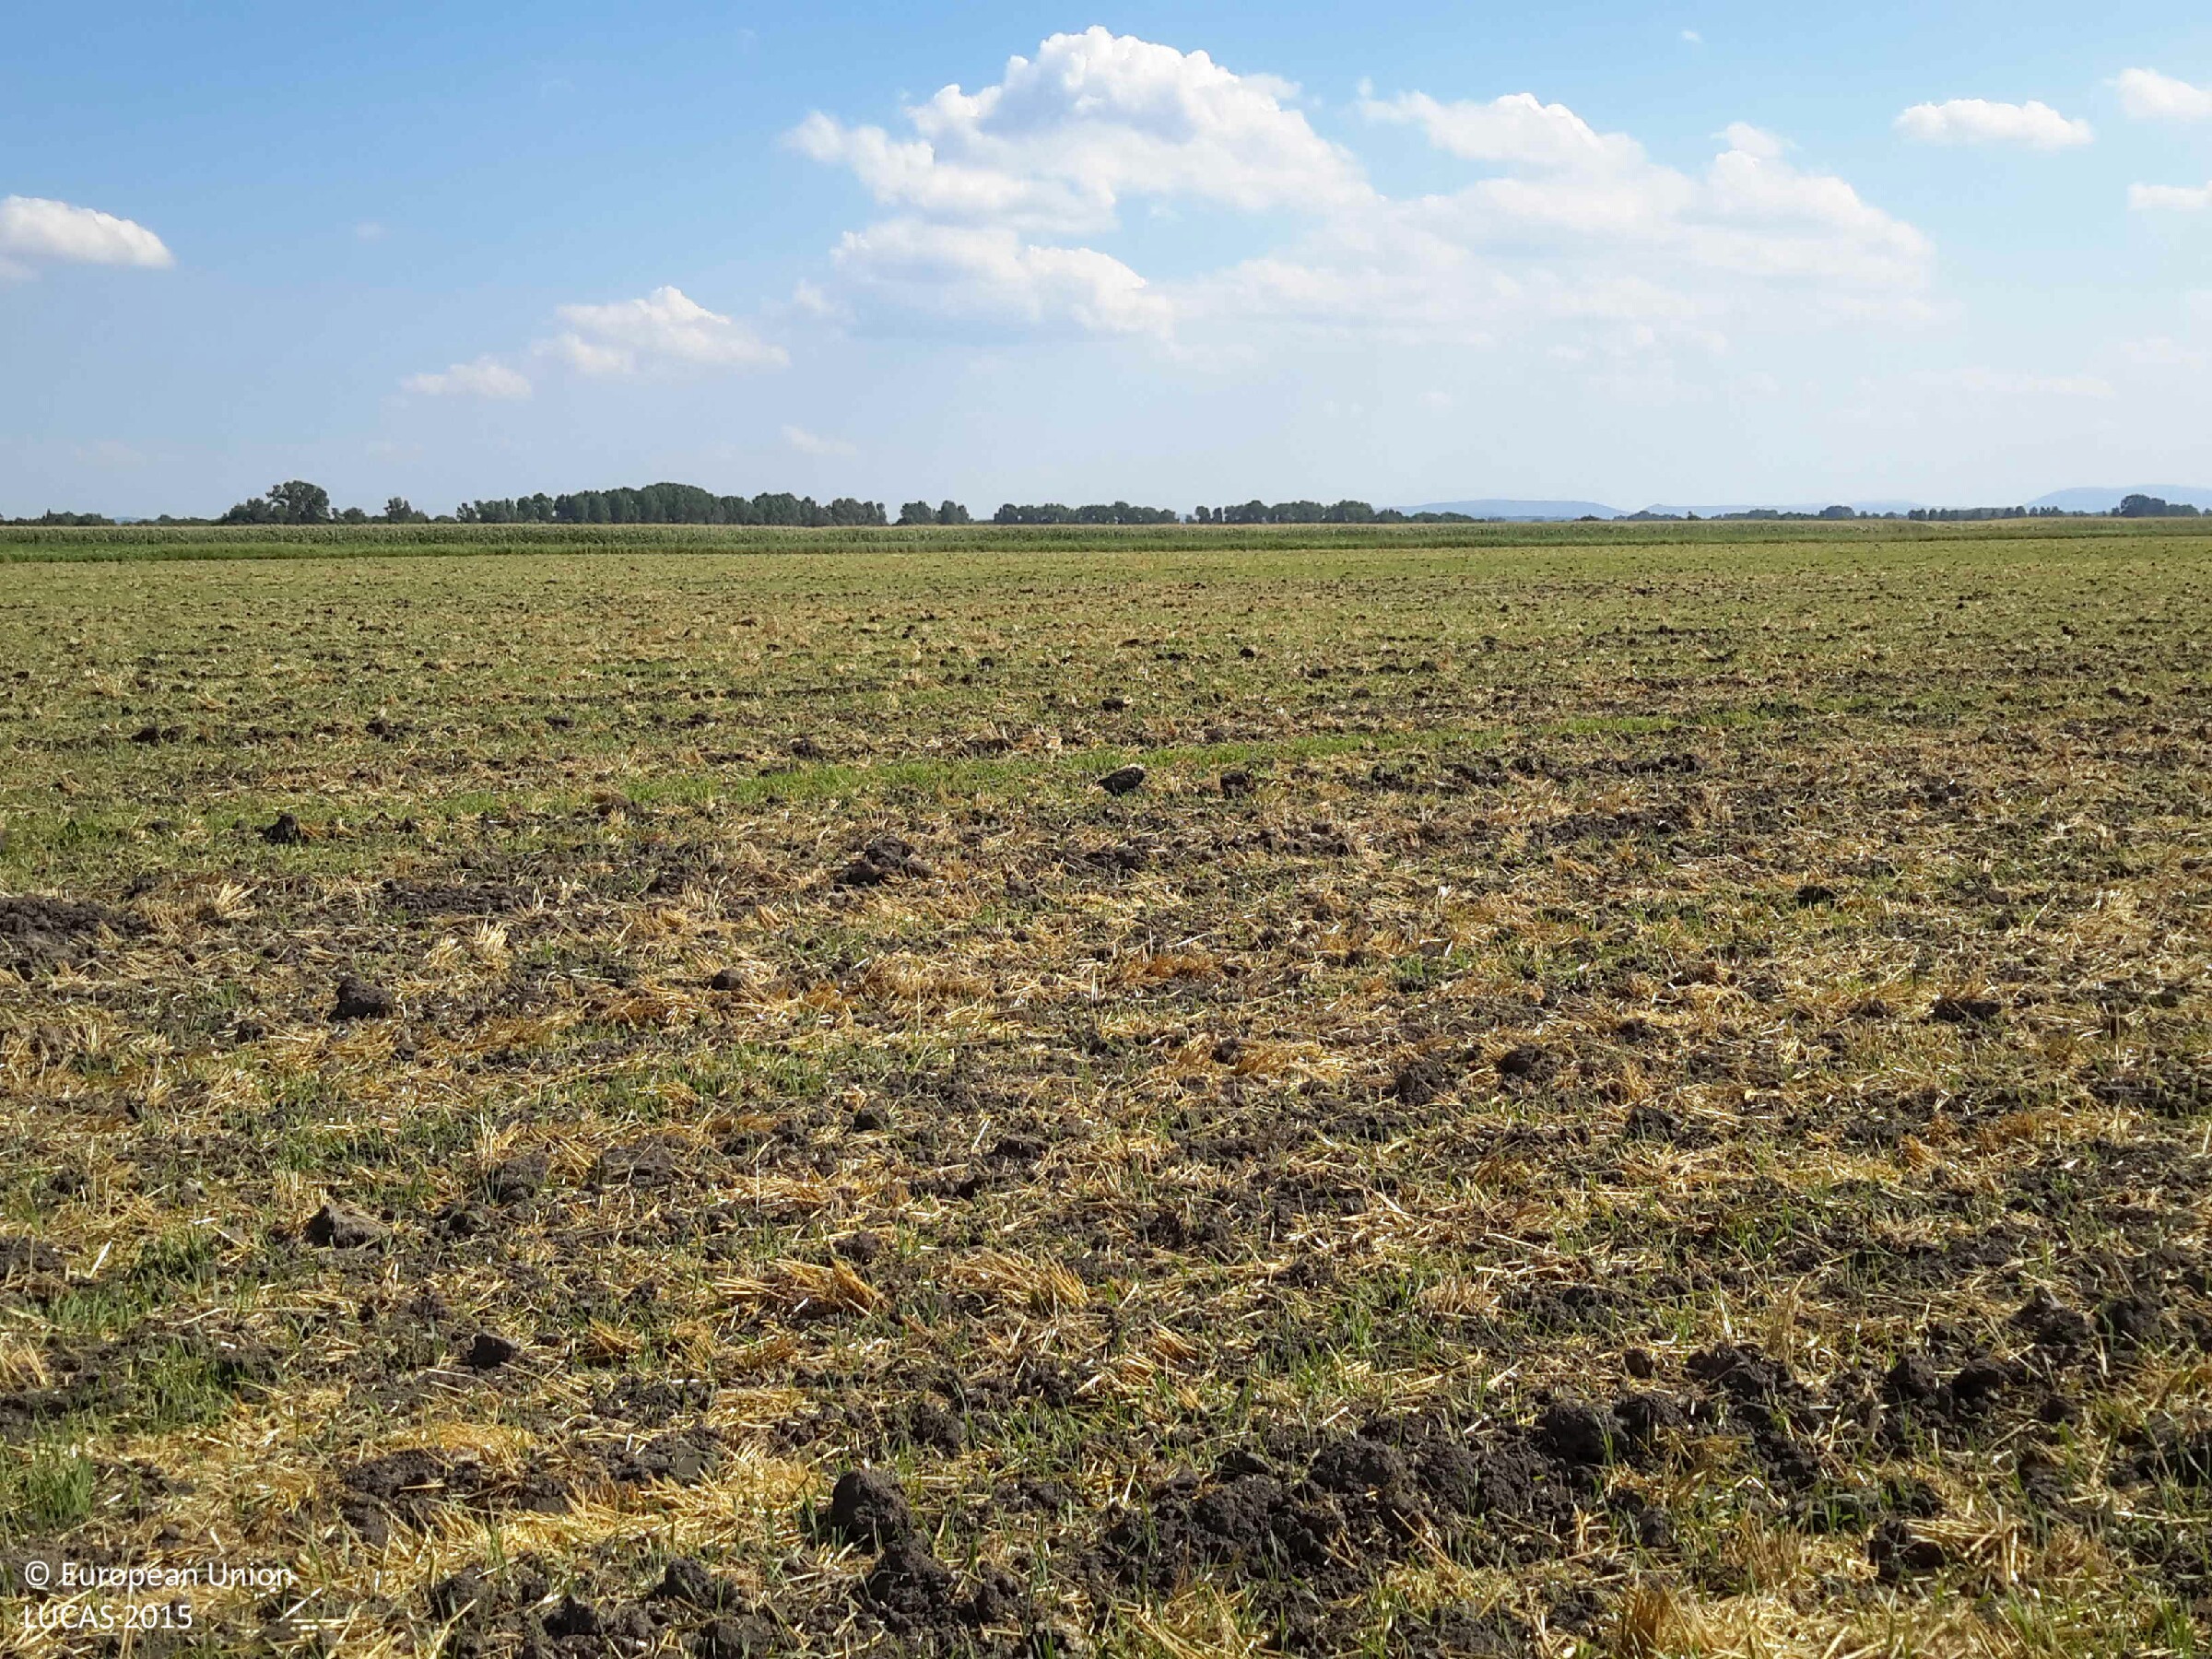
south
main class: Cropland
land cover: Common wheat
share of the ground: < 10 %
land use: Agriculture (excluding fallow land and kitchen gardens)
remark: Harvested field
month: July
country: HU
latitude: 47.5626
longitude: 17.8651
